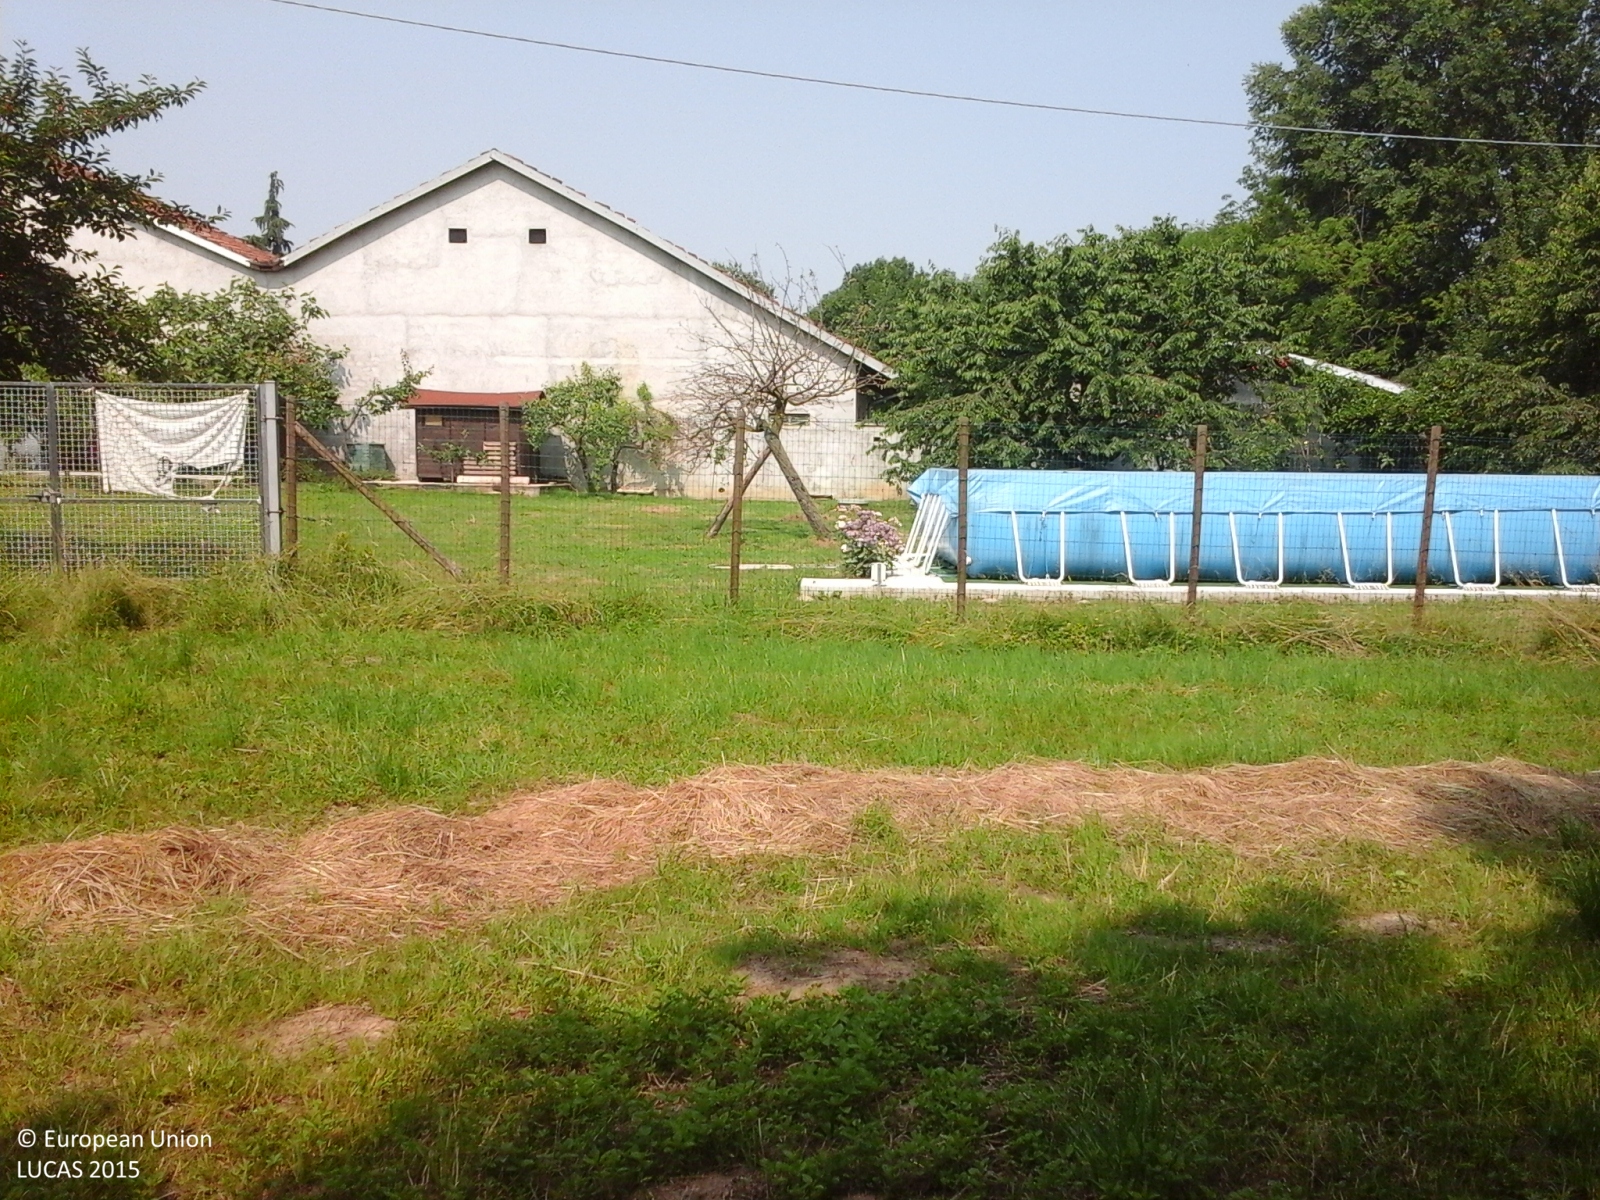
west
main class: Grassland
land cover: Grassland with sparse tree/shrub cover
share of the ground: > 75 %
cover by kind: herbaceous plants 90 %, broadleaved forest trees 5 %, shrubs 5 %
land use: Residential
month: May
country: IT
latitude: 45.2264
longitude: 7.6732
